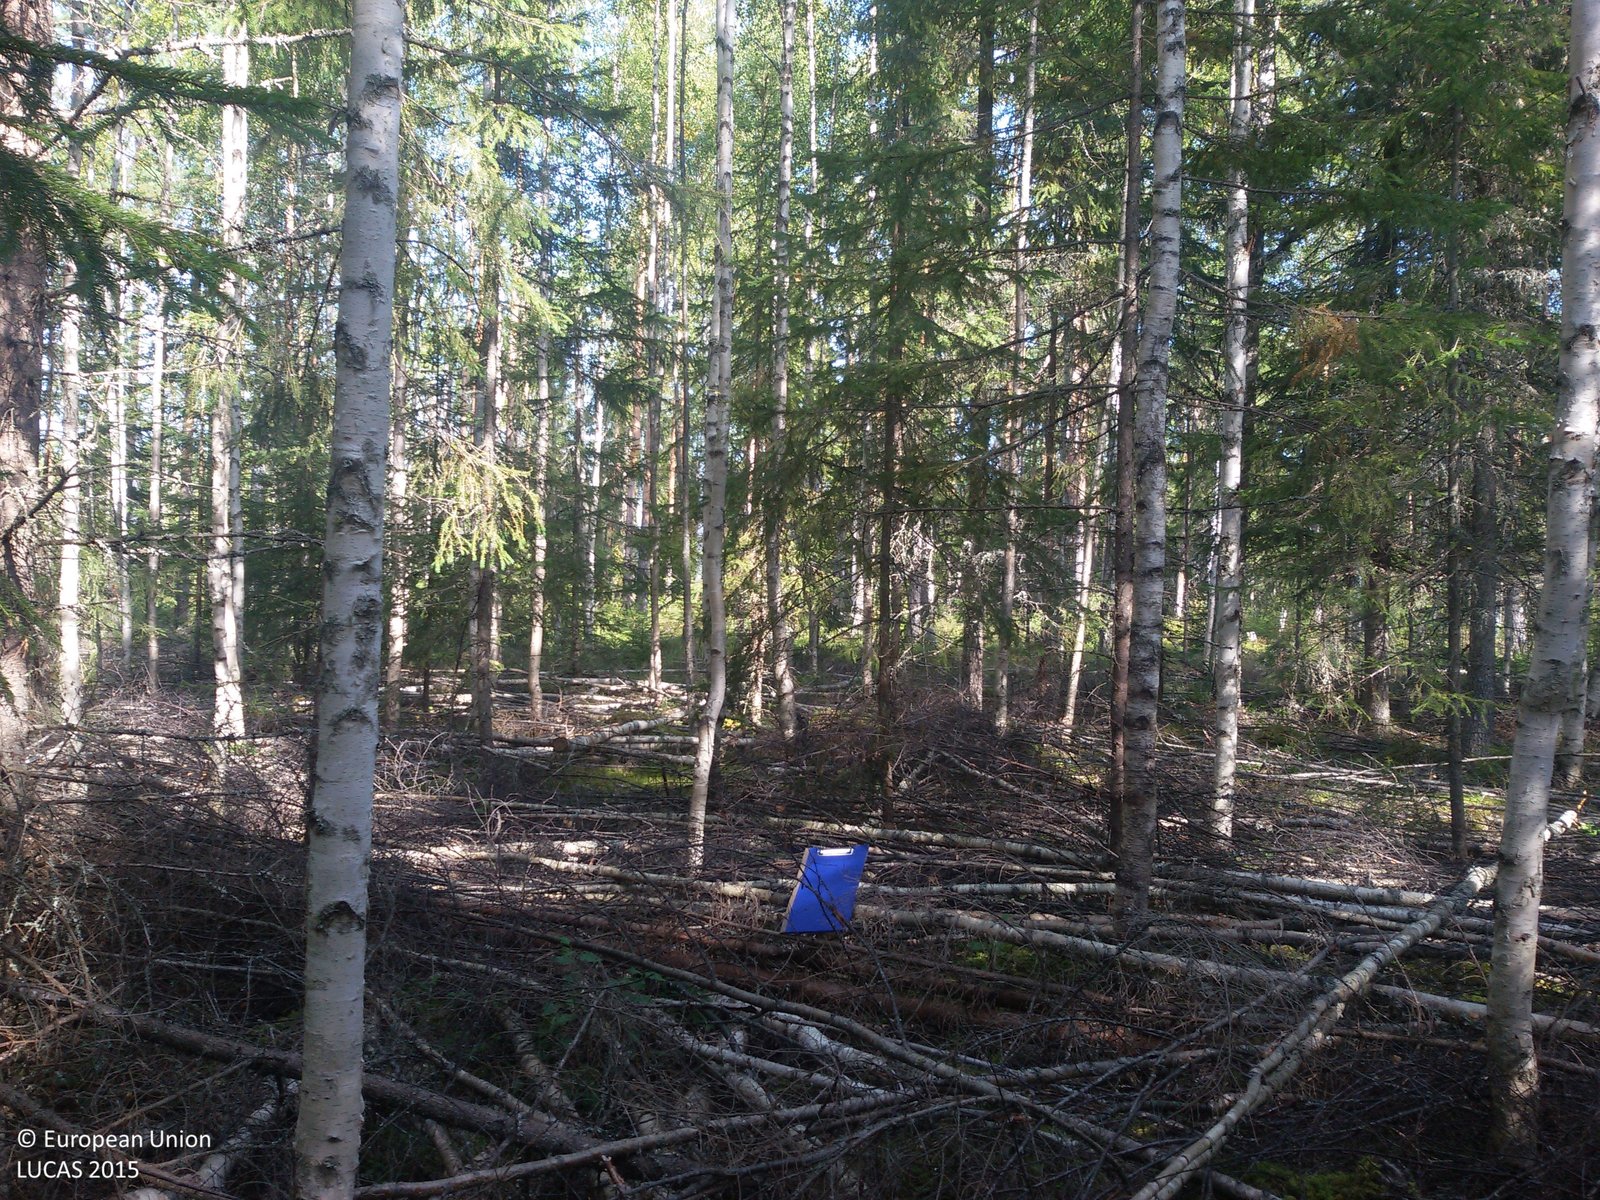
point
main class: Woodland
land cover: Spruce dominated mixed woodland
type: boreal forest
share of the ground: > 75 %
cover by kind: coniferous forest trees 50 %, broadleaved forest trees 30 %, lichens and mosses 10 %
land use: Forestry
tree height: > 5 m
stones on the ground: > 50 %
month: September
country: SE
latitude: 60.9598
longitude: 14.9541
